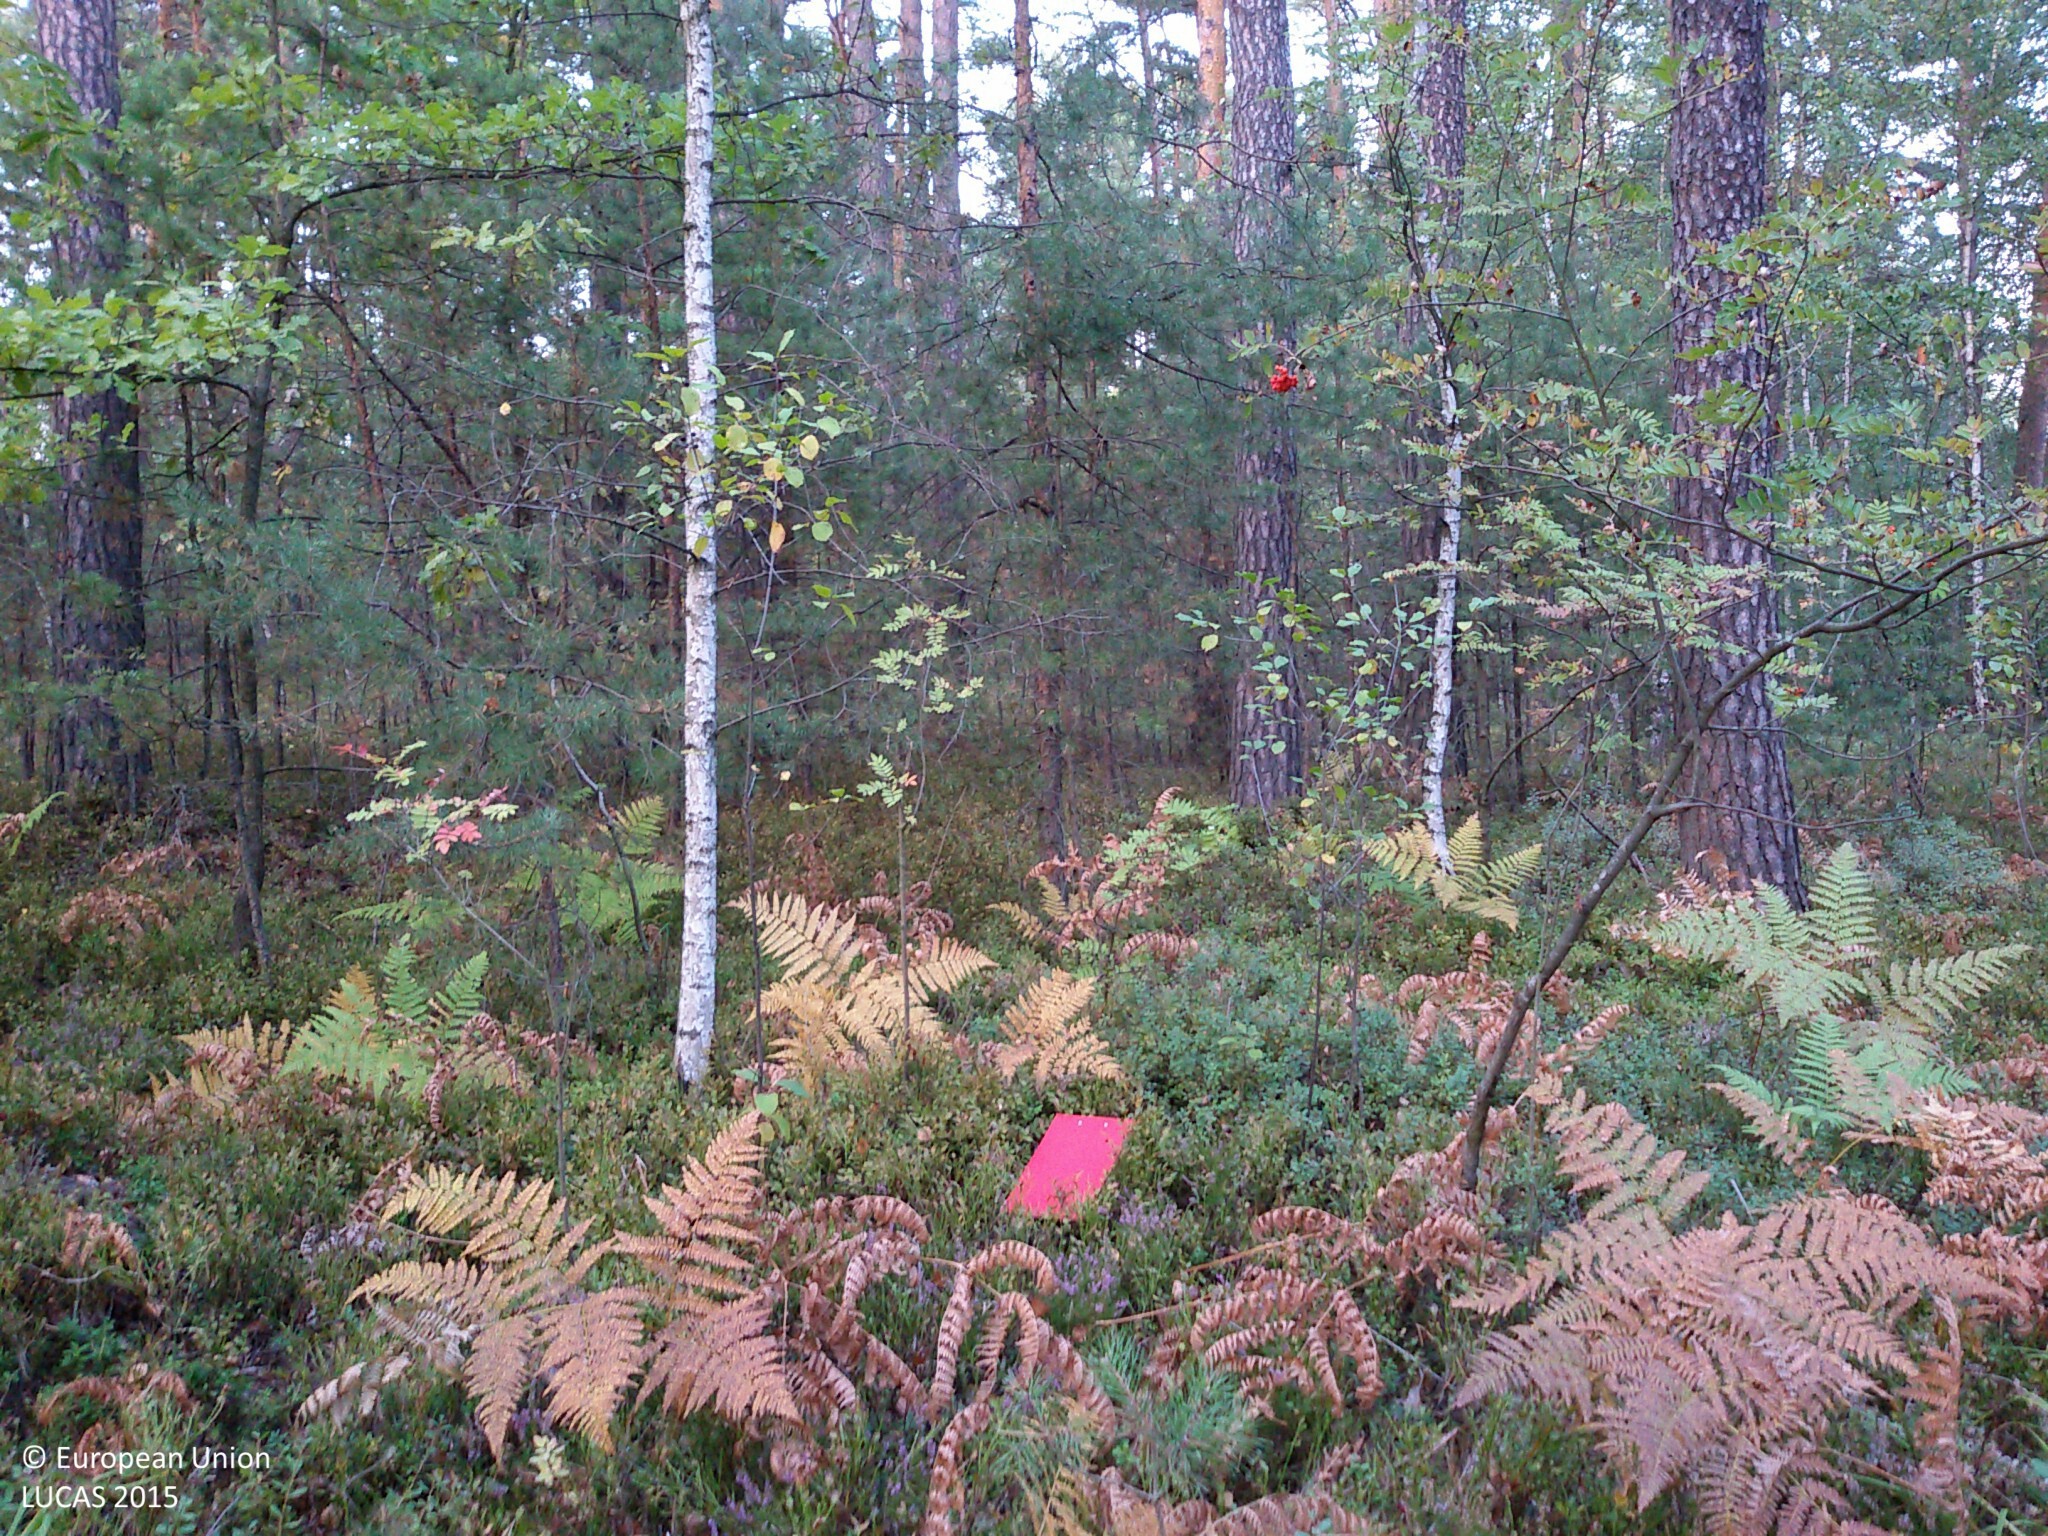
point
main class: Woodland
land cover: Pine dominated mixed woodland
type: hemiboreal forest and nemoral coniferous forest and mixed broadleaved-coniferous forest
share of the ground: > 75 %
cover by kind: coniferous forest trees 70 %, broadleaved forest trees 25 %, shrubs 5 %
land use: Forestry
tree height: > 5 m
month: September
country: PL
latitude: 50.5310
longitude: 23.2987
